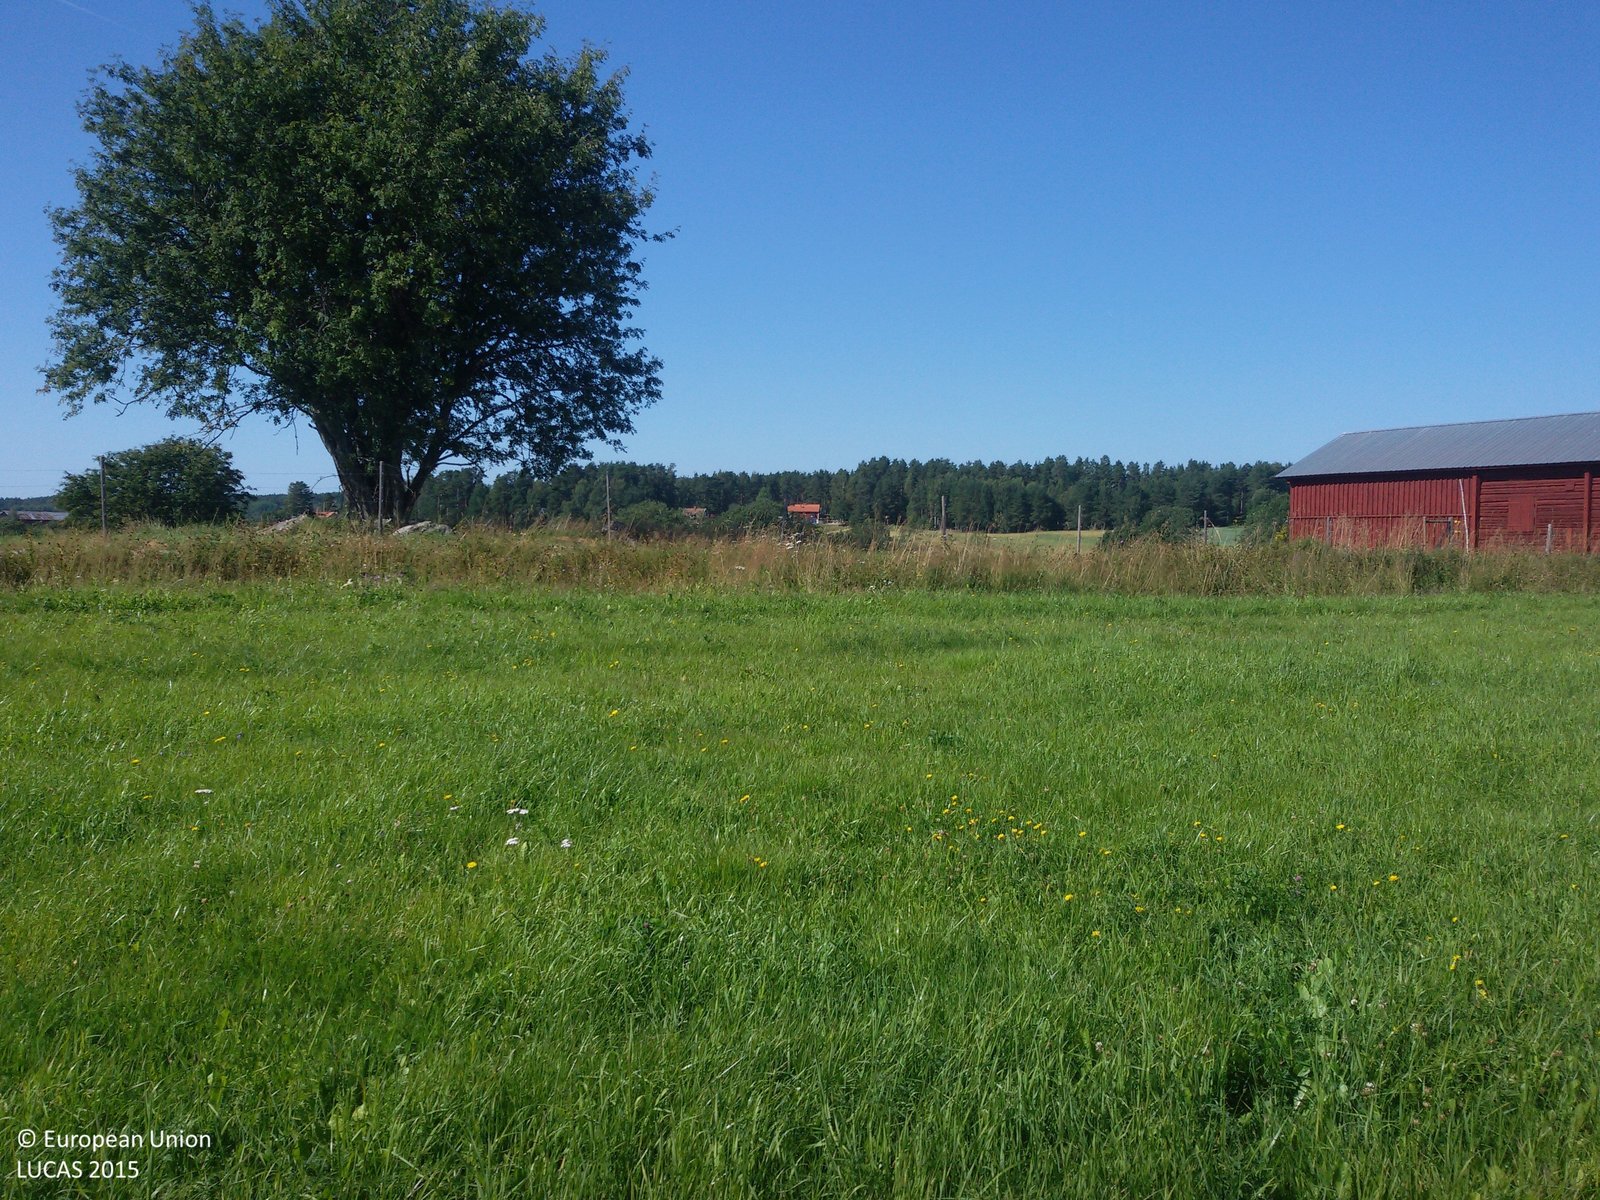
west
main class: Grassland
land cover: Grassland without tree/shrub cover
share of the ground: > 75 %
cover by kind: herbaceous plants 100 %
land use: Agriculture (excluding fallow land and kitchen gardens)
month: August
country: SE
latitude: 60.6370
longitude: 15.8561
